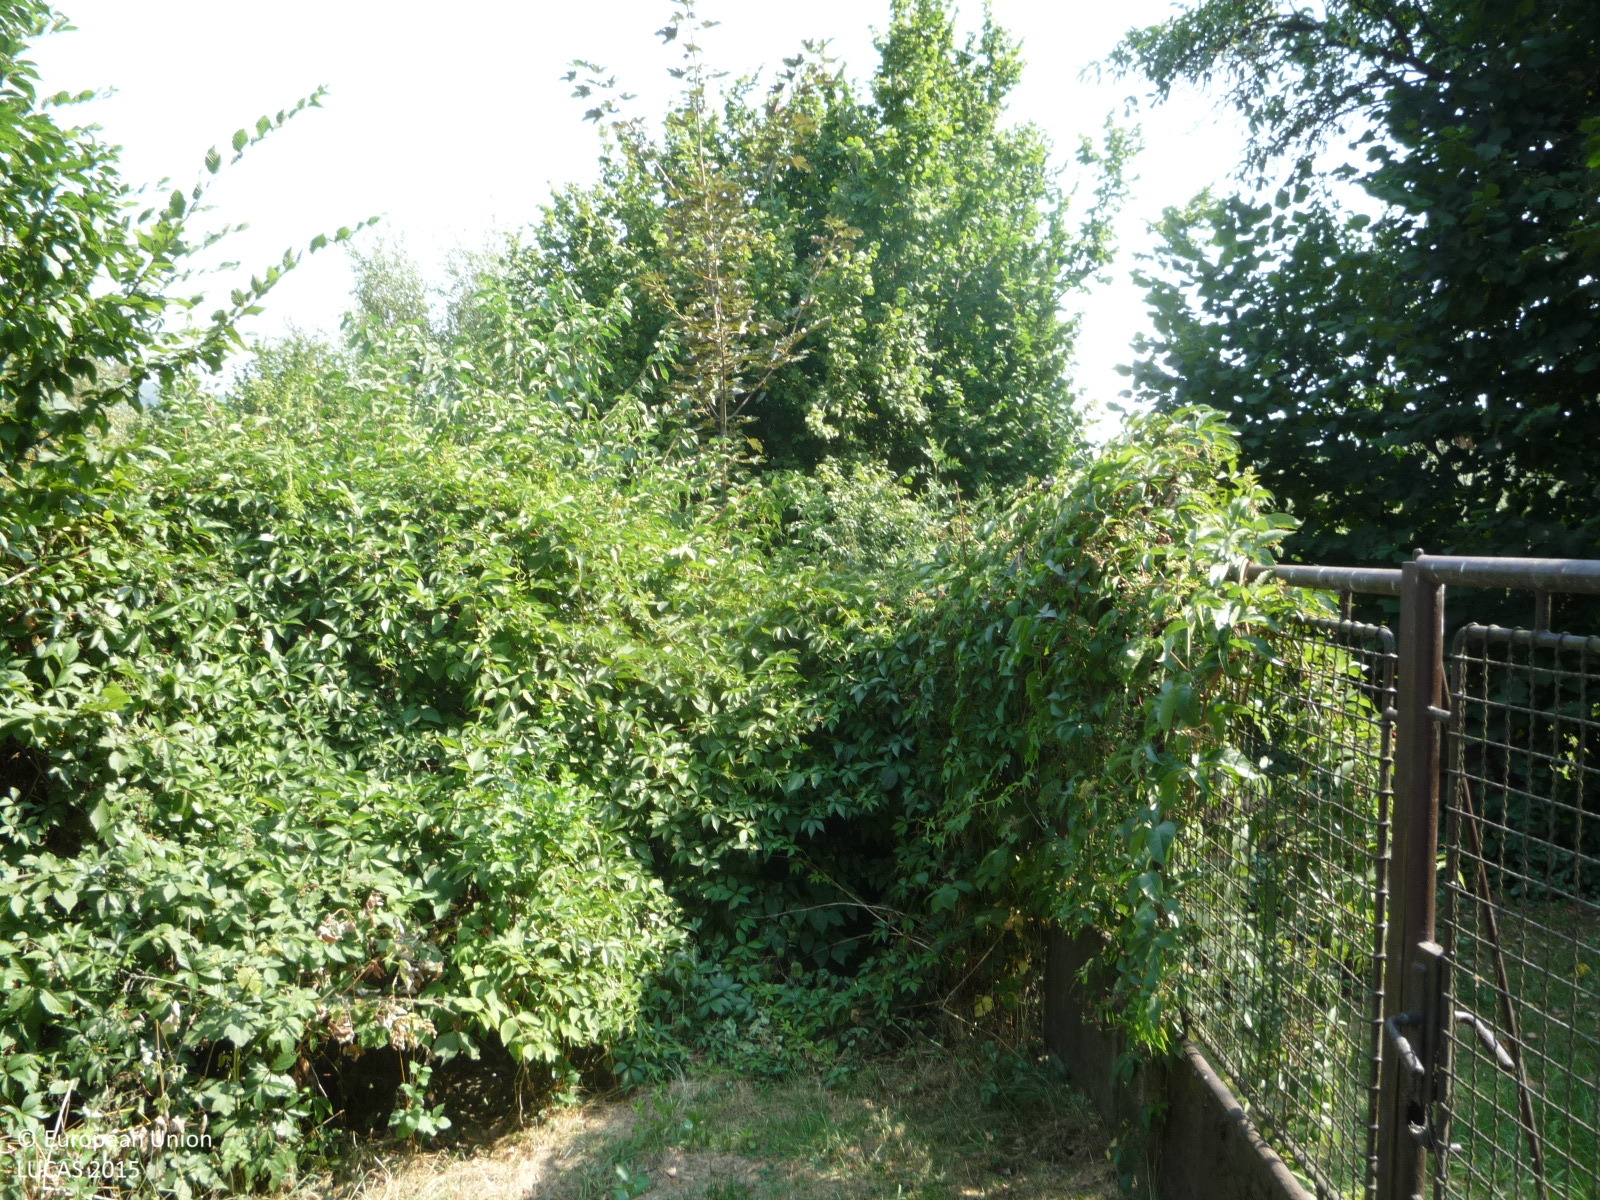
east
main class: Cropland
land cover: Apple fruit
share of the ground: 25 - 50 %
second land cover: Grassland without tree/shrub cover
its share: 25 - 50 %
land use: Kitchen garden
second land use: Amenities, museums, leisure
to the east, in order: Apple fruit; Grassland without tree/shrub cover; Fences; Grass margins; Shrubland with sparse tree cover; Tracks; Broadleaved woodland; Fences; Broadleaved woodland; Artificial constructions in urban areas; Rivers and streams; Artificial constructions in urban areas; Broadleaved woodland; Railways; Spruce dominated mixed woodland; Artificial constructions in urban areas
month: August
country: CZ
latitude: 49.8795
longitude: 14.4966
